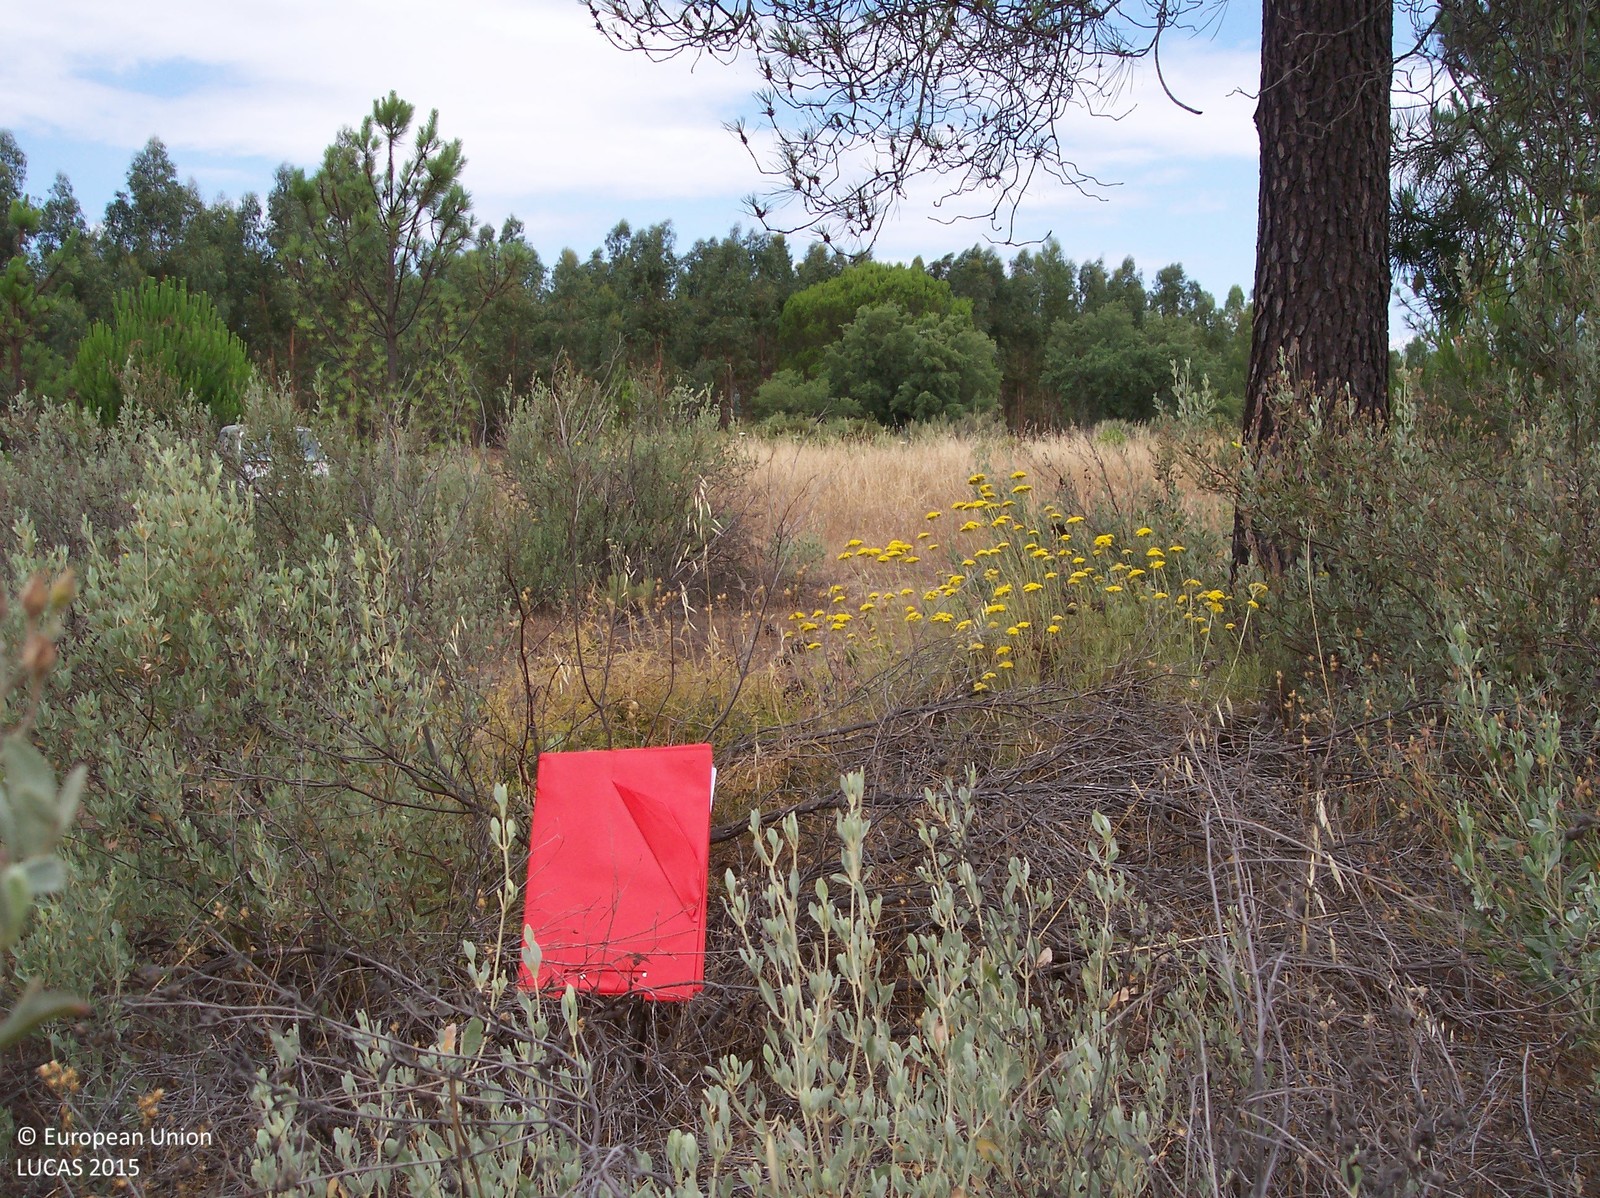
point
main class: Shrubland
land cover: Shrubland with sparse tree cover
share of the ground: > 75 %
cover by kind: shrubs 70 %, herbaceous plants 25 %, coniferous forest trees 5 %
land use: Semi-natural and natural areas not in use
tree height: > 5 m
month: June
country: ES
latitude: 37.3196
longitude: -6.4490
